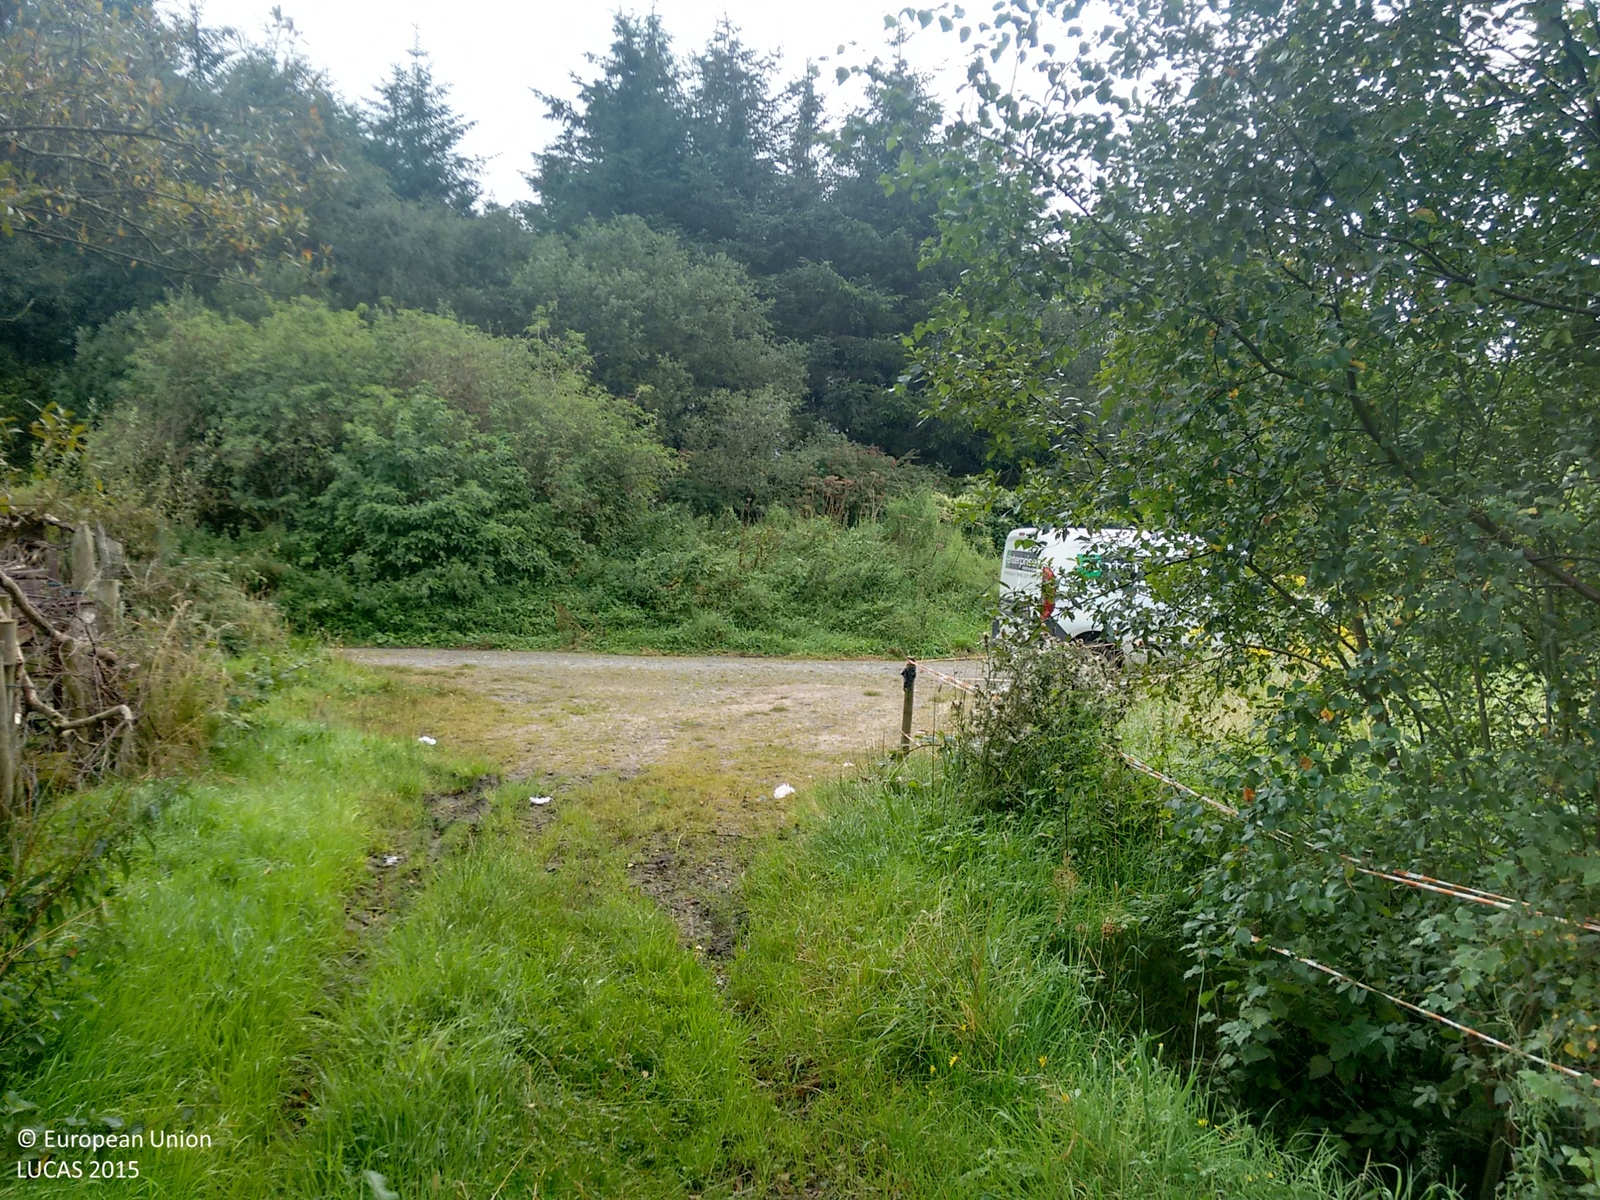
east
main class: Grassland
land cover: Grassland without tree/shrub cover
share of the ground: > 75 %
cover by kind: herbaceous plants 100 %
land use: Agriculture (excluding fallow land and kitchen gardens)
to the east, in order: Grassland without tree/shrub cover; Ditches and canals; Managed hedges; Fences; Grassland without tree/shrub cover; Abandoned hedges; Fences; Grass margins; Paved roads, cycling and walking lanes; Grass margins; Spruce dominated coniferous woodland; Fences; Grassland without tree/shrub cover; Shrubland with sparse tree cover; Grassland without tree/shrub cover
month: September
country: IE
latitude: 55.0729
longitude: -7.2964
